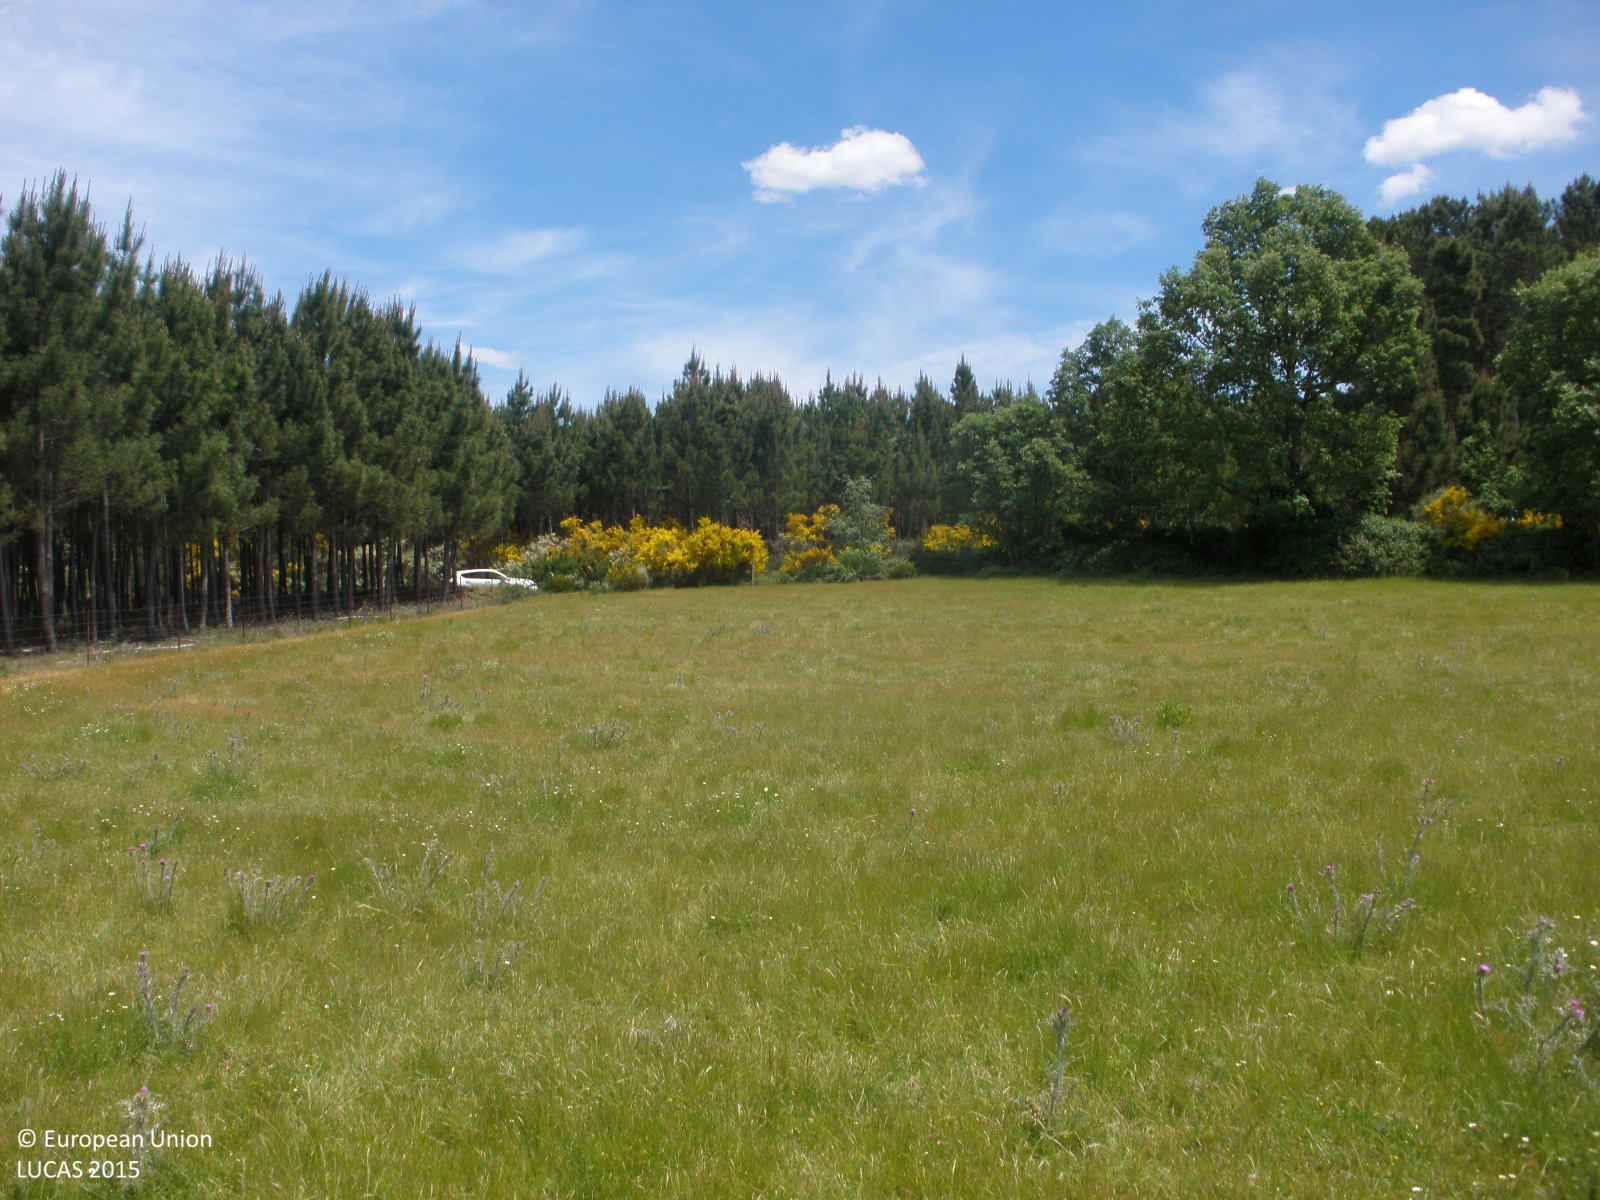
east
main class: Grassland
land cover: Grassland without tree/shrub cover
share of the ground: > 75 %
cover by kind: herbaceous plants 100 %
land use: Agriculture (excluding fallow land and kitchen gardens)
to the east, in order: Grassland without tree/shrub cover; Fences; Broadleaved woodland; Tracks; Shruby margins; Pine dominated coniferous woodland; Shruby margins; Tracks; Fences; Pine dominated coniferous woodland; Shruby margins; Grassland without tree/shrub cover
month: May
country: ES
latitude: 40.3691
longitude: -6.6109
